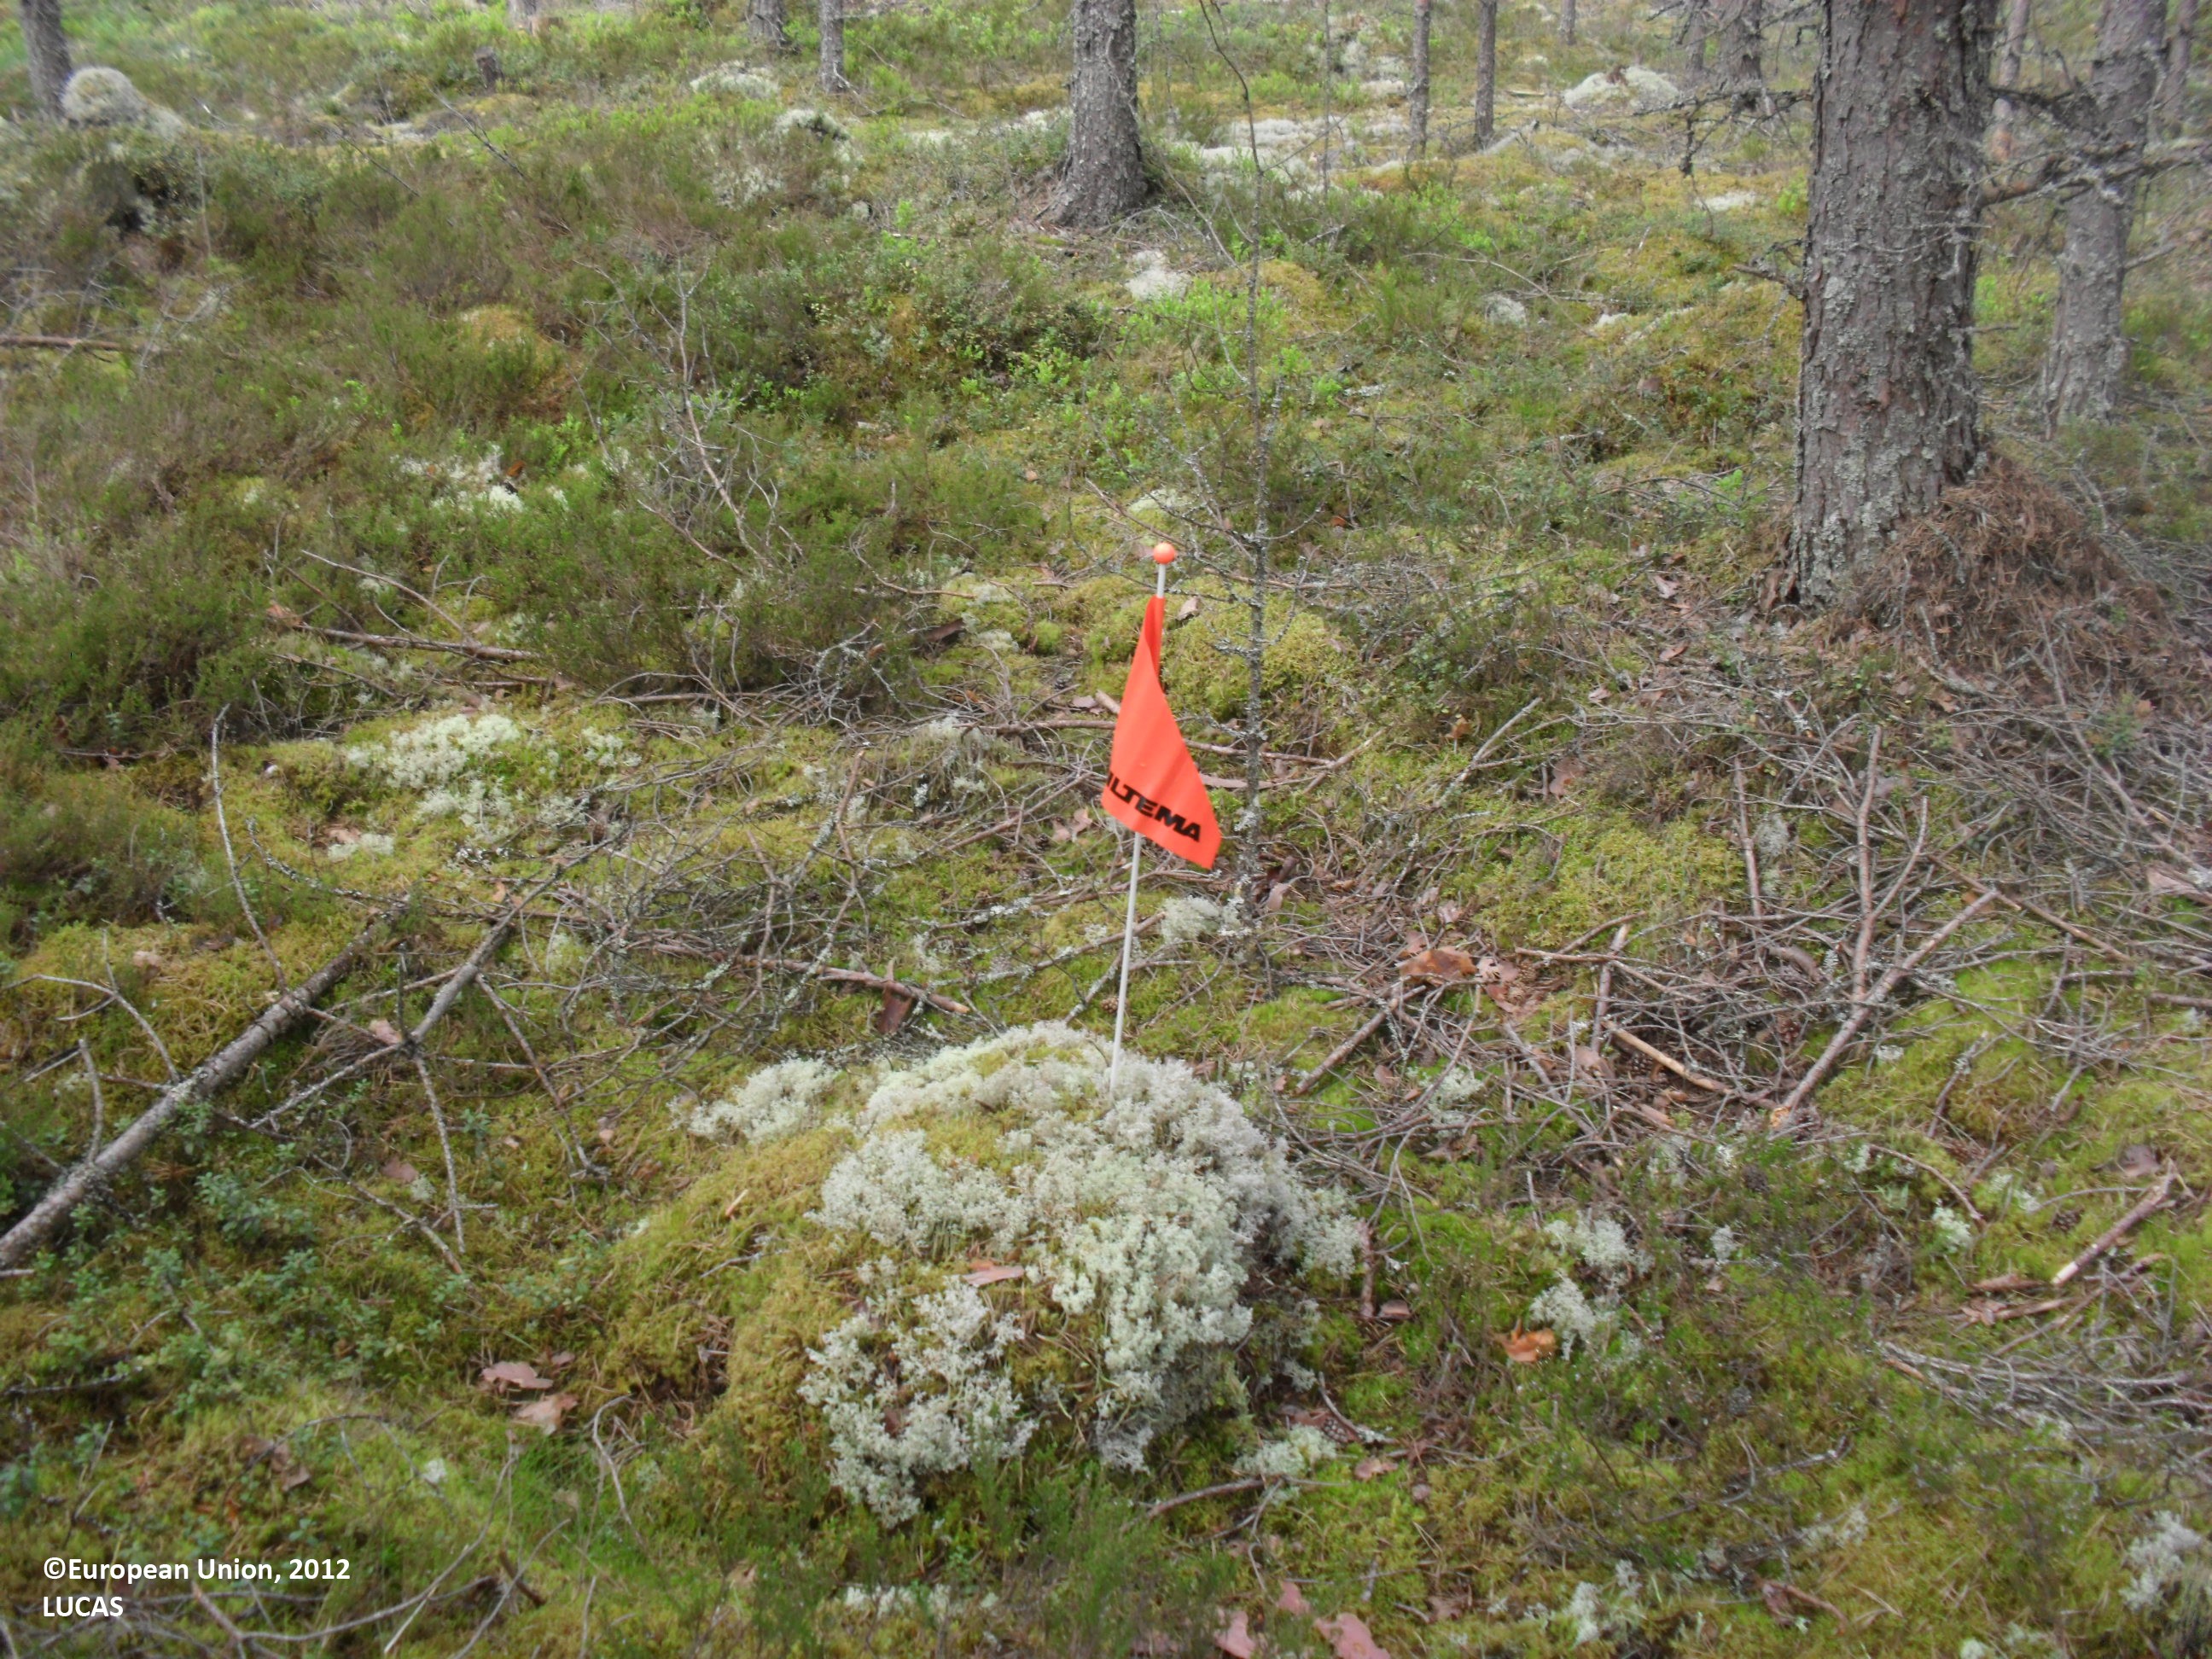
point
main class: Woodland
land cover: Pine dominated coniferous woodland
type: boreal forest
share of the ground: 50 - 75 %
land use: Forestry
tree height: > 5 m
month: June
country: FI
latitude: 62.7894
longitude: 23.2970
